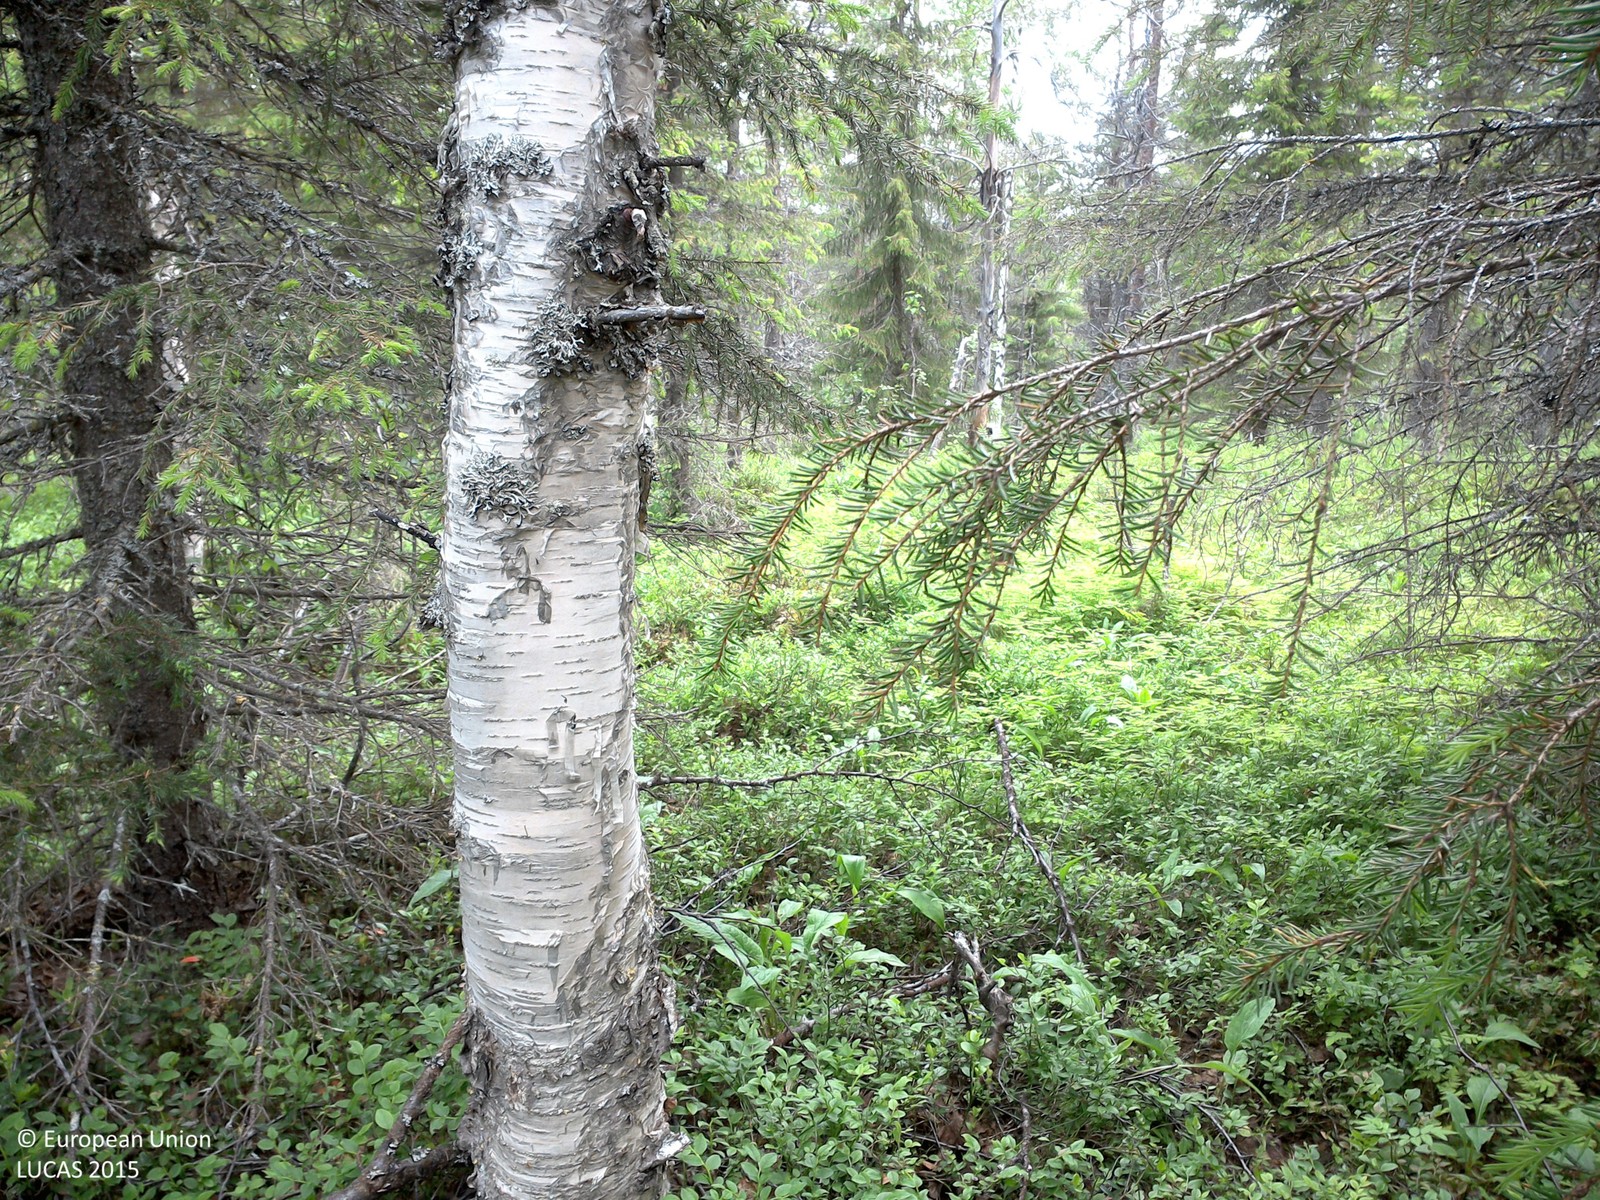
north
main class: Woodland
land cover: Spruce dominated mixed woodland
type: boreal forest
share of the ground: 25 - 50 %
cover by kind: shrubs 45 %, coniferous forest trees 30 %, herbaceous plants 15 %, broadleaved forest trees 10 %
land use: Forestry
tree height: > 5 m
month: July
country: SE
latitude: 66.7634
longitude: 23.4950
